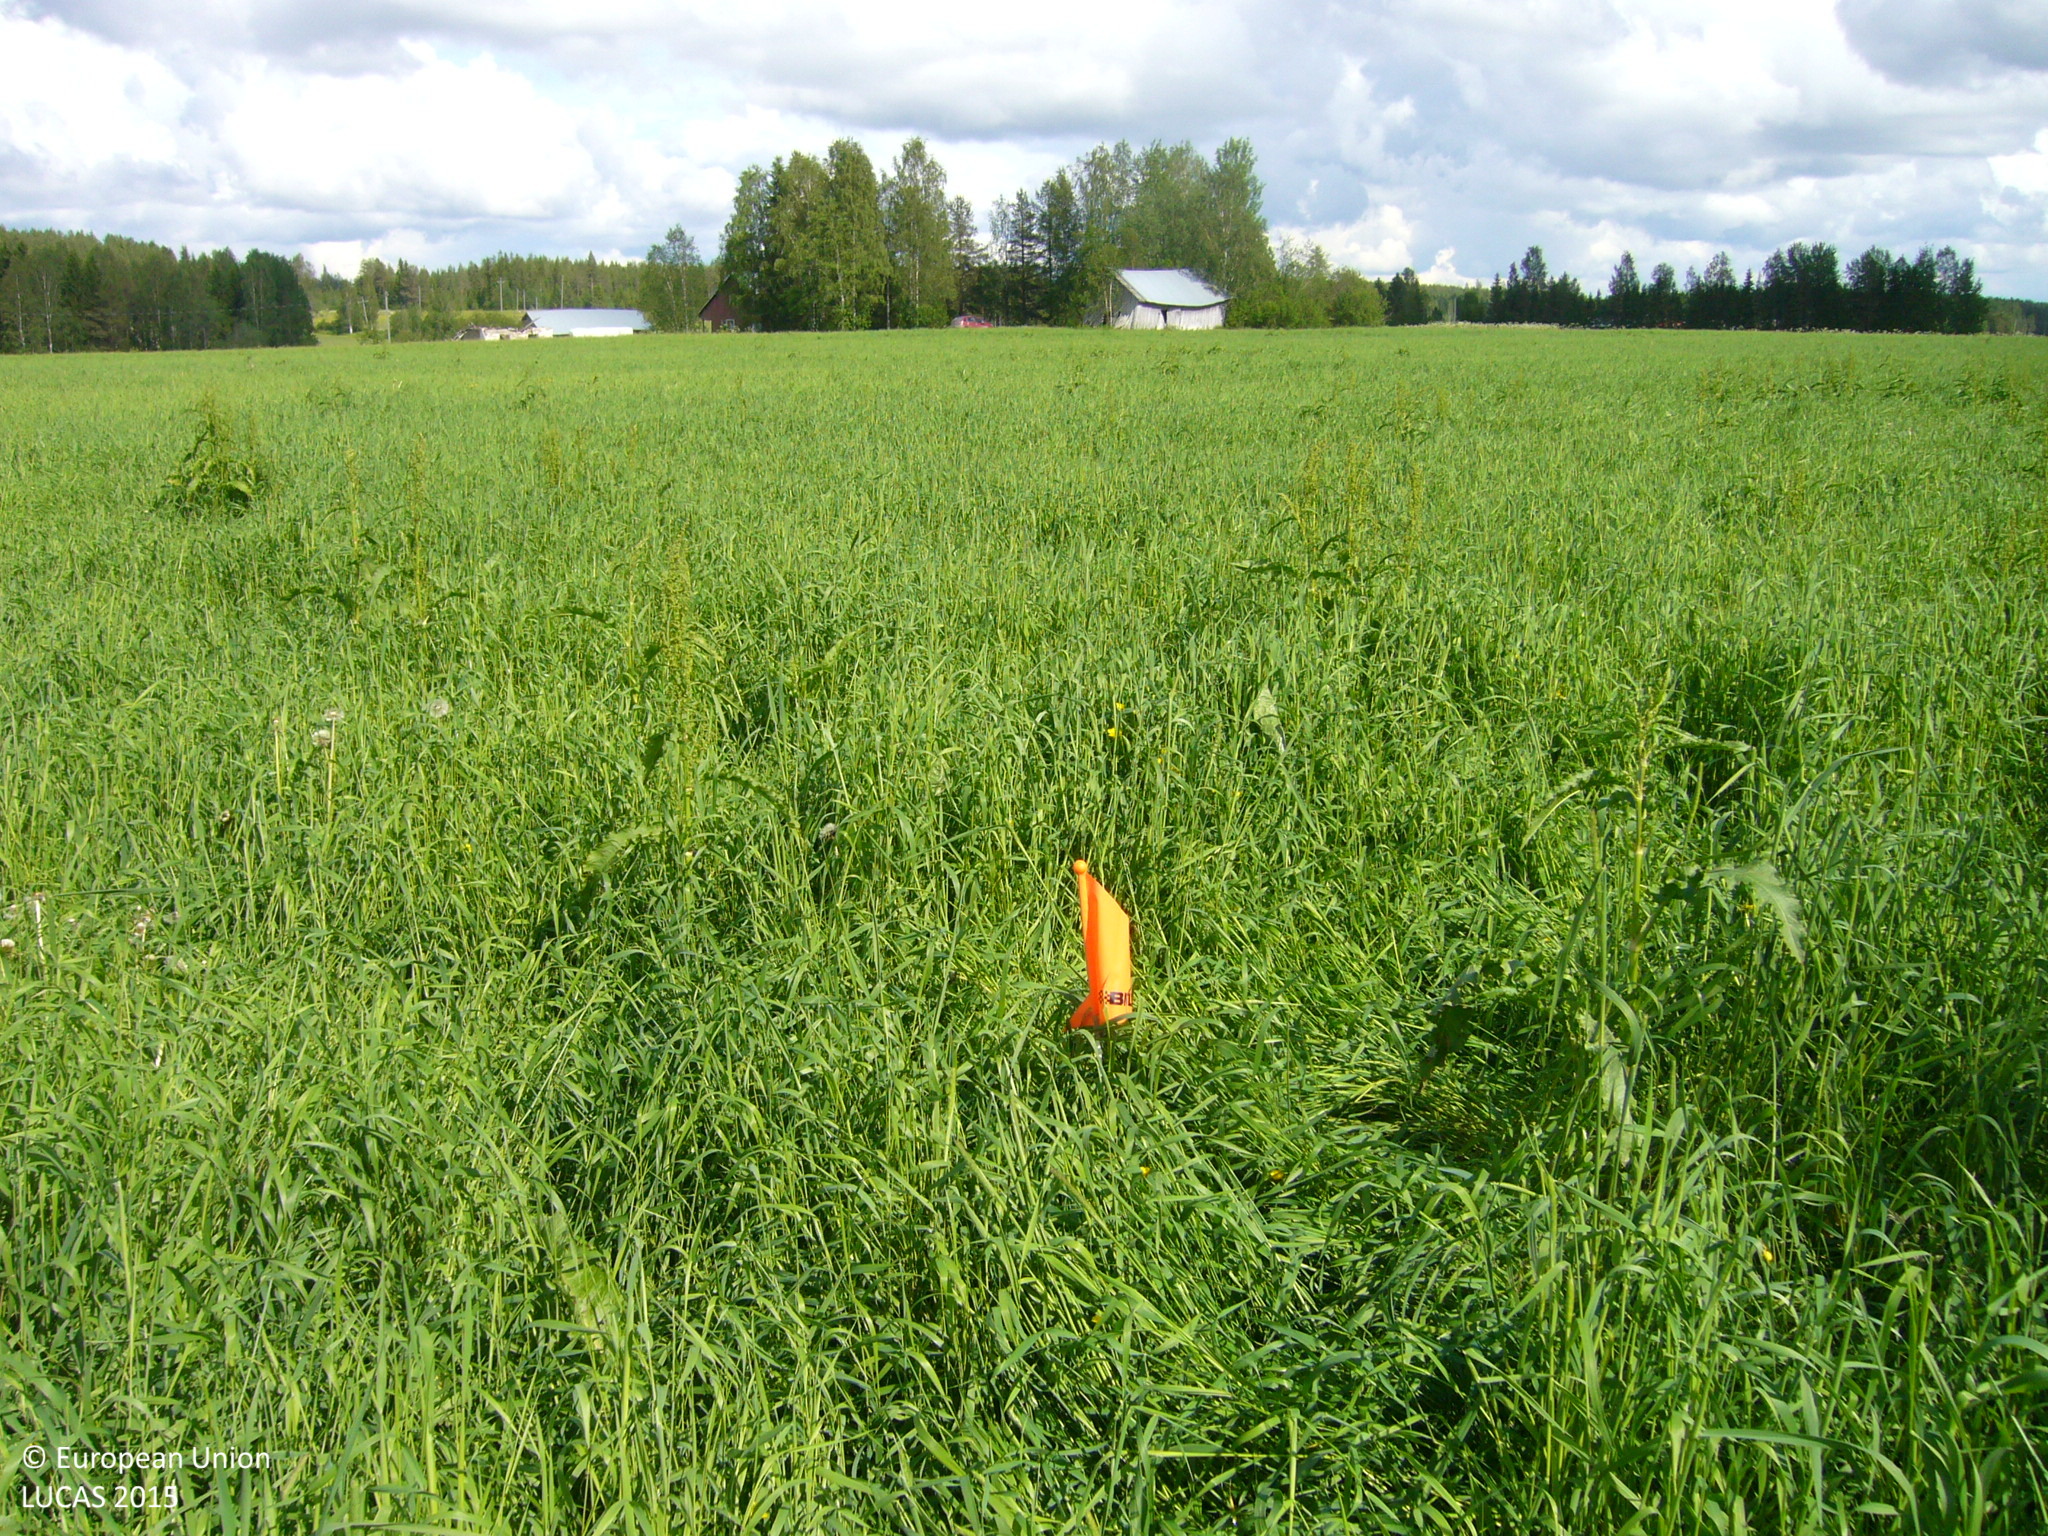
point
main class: Cropland
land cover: Temporary grasslands
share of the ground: > 75 %
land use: Agriculture (excluding fallow land and kitchen gardens)
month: June
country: FI
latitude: 63.7842
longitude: 26.3302
